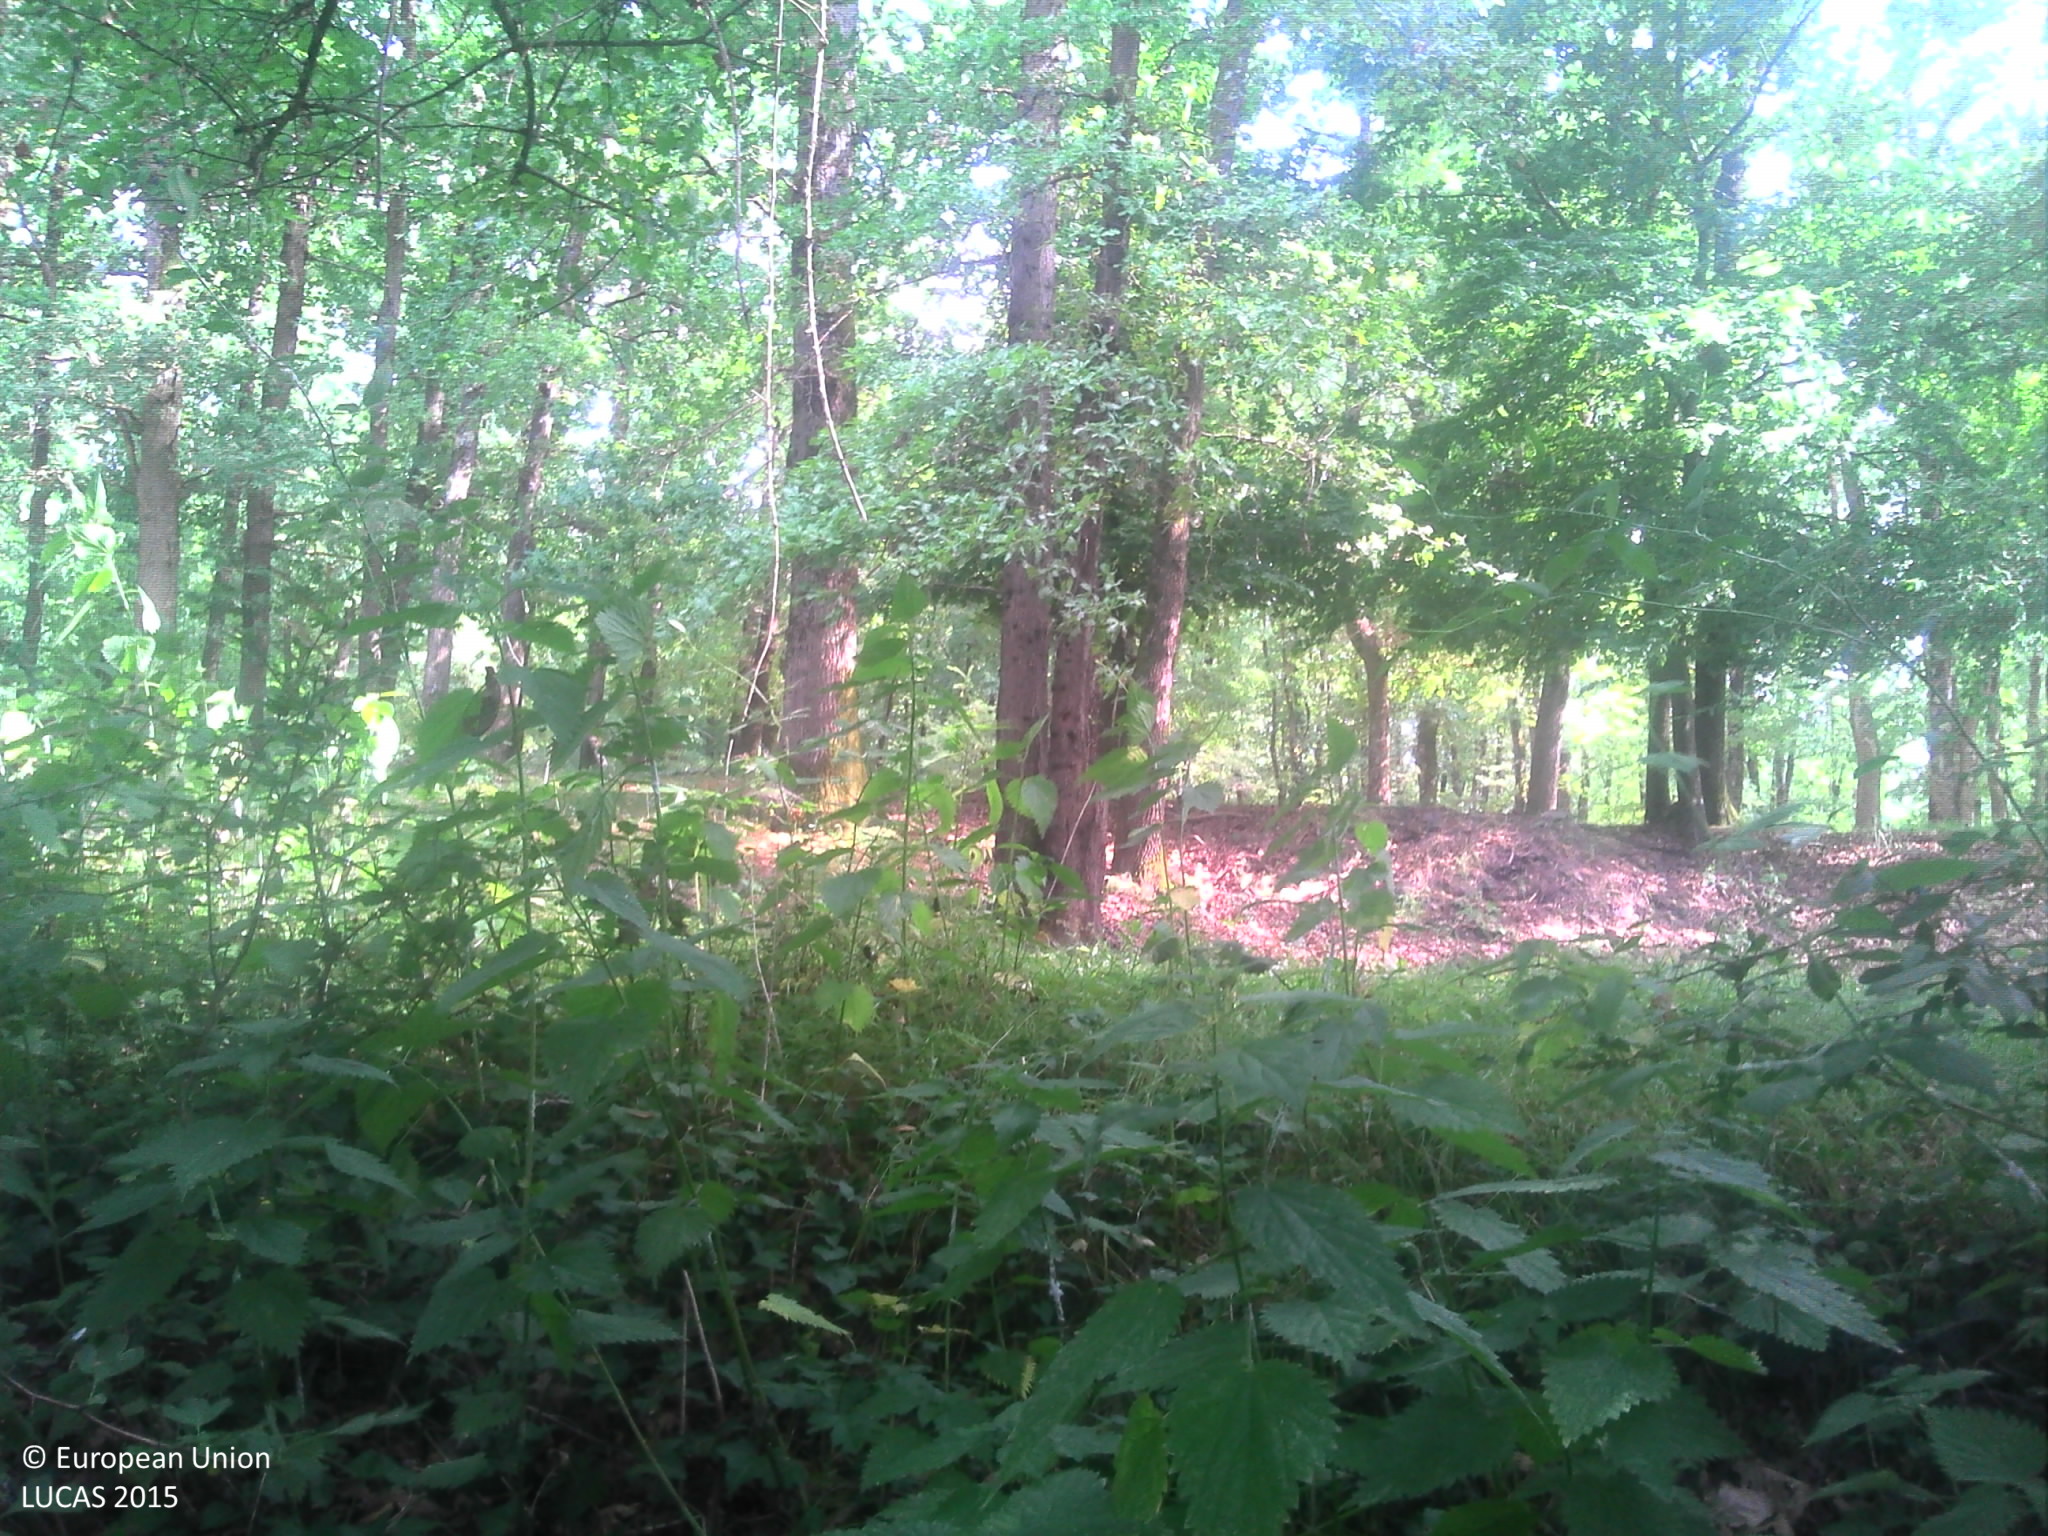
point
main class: Woodland
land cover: Broadleaved woodland
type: acidophilous oak and oak-birch forest
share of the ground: > 75 %
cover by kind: broadleaved forest trees 65 %, herbaceous plants 35 %
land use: Forestry
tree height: > 5 m
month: July
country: FR
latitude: 43.6099
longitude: 1.5904
